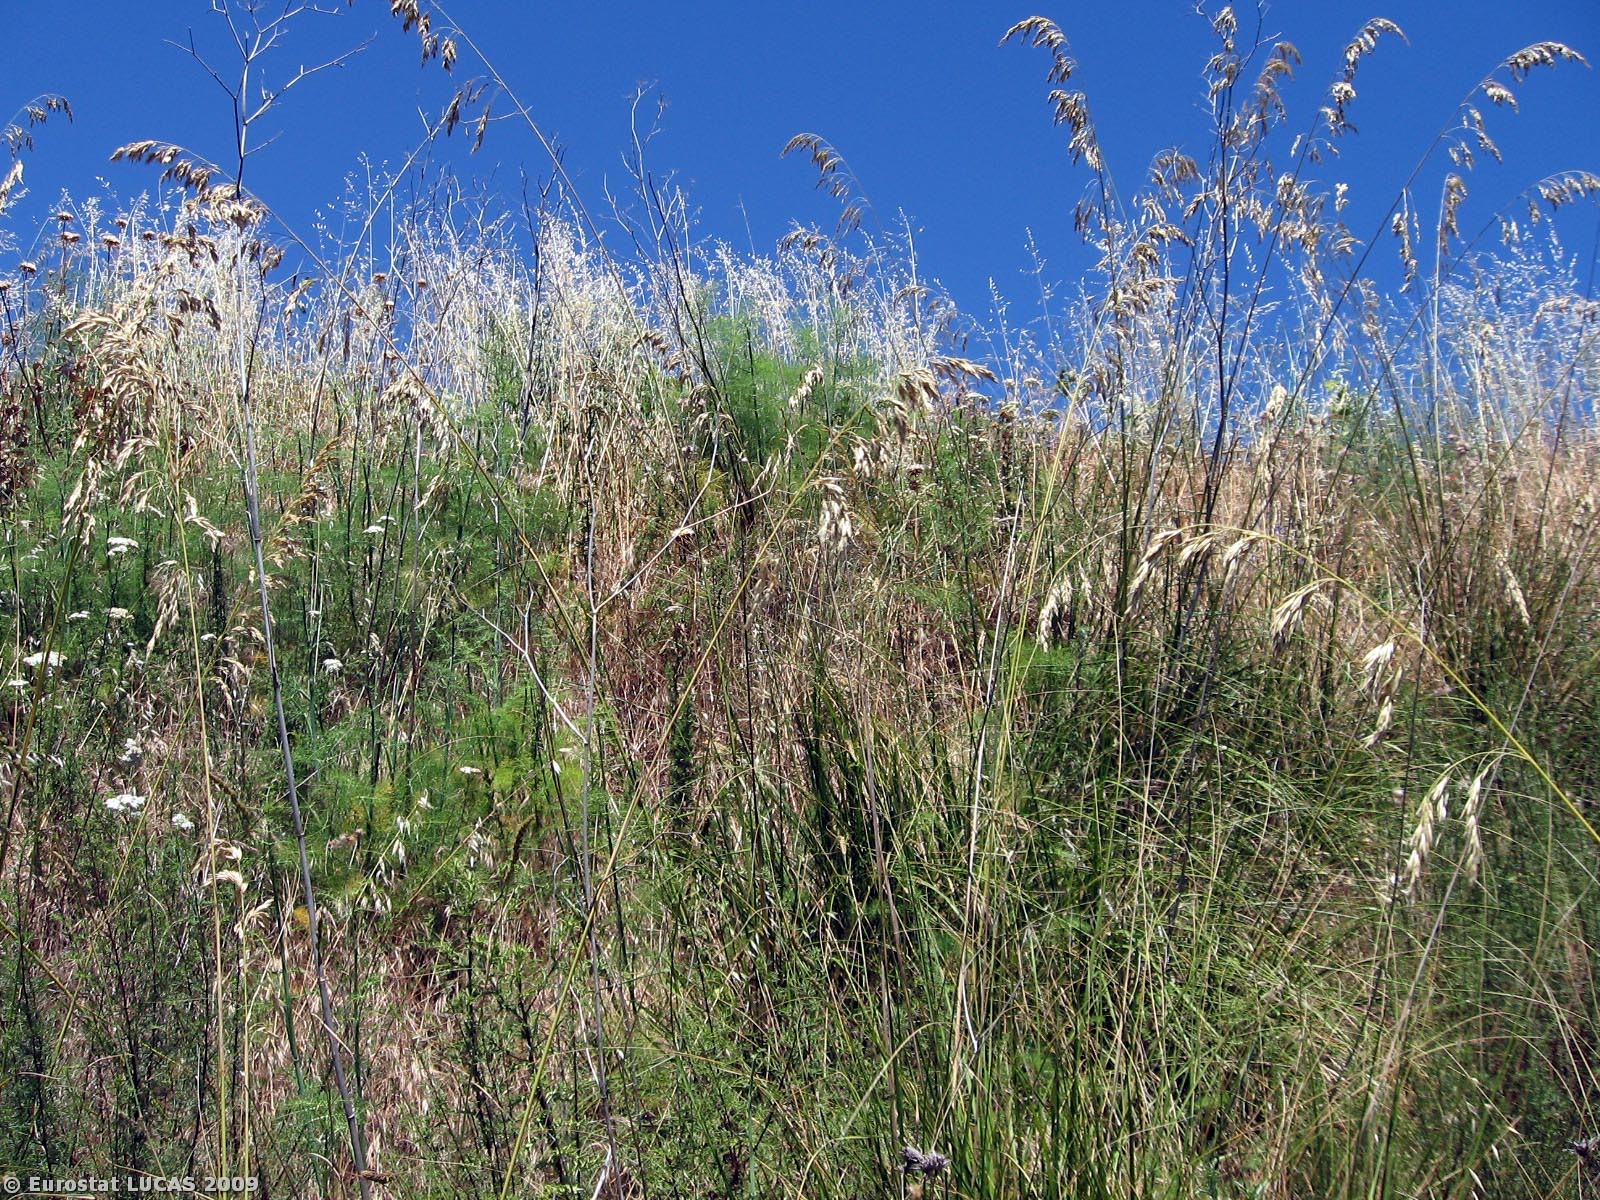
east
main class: Grassland
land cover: Grassland without tree/shrub cover
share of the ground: 50 - 75 %
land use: Unused
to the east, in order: Grassland without tree/shrub cover; Vineyards; Bare land; Olive groves; Bare land; Vineyards; Bare land; Fences; Abandoned hedges; Vineyards; Bare land; Olive groves; Bare land; Grass margins; Olive groves; Bare land; Grass margins; Tracks; Fences; Olive groves; Bare land; Electric lines; Groves; Olive groves; Bare land; Shrubland with sparse tree cover; Olive groves; Bare land
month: June
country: IT
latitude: 38.6434
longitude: 16.0895
